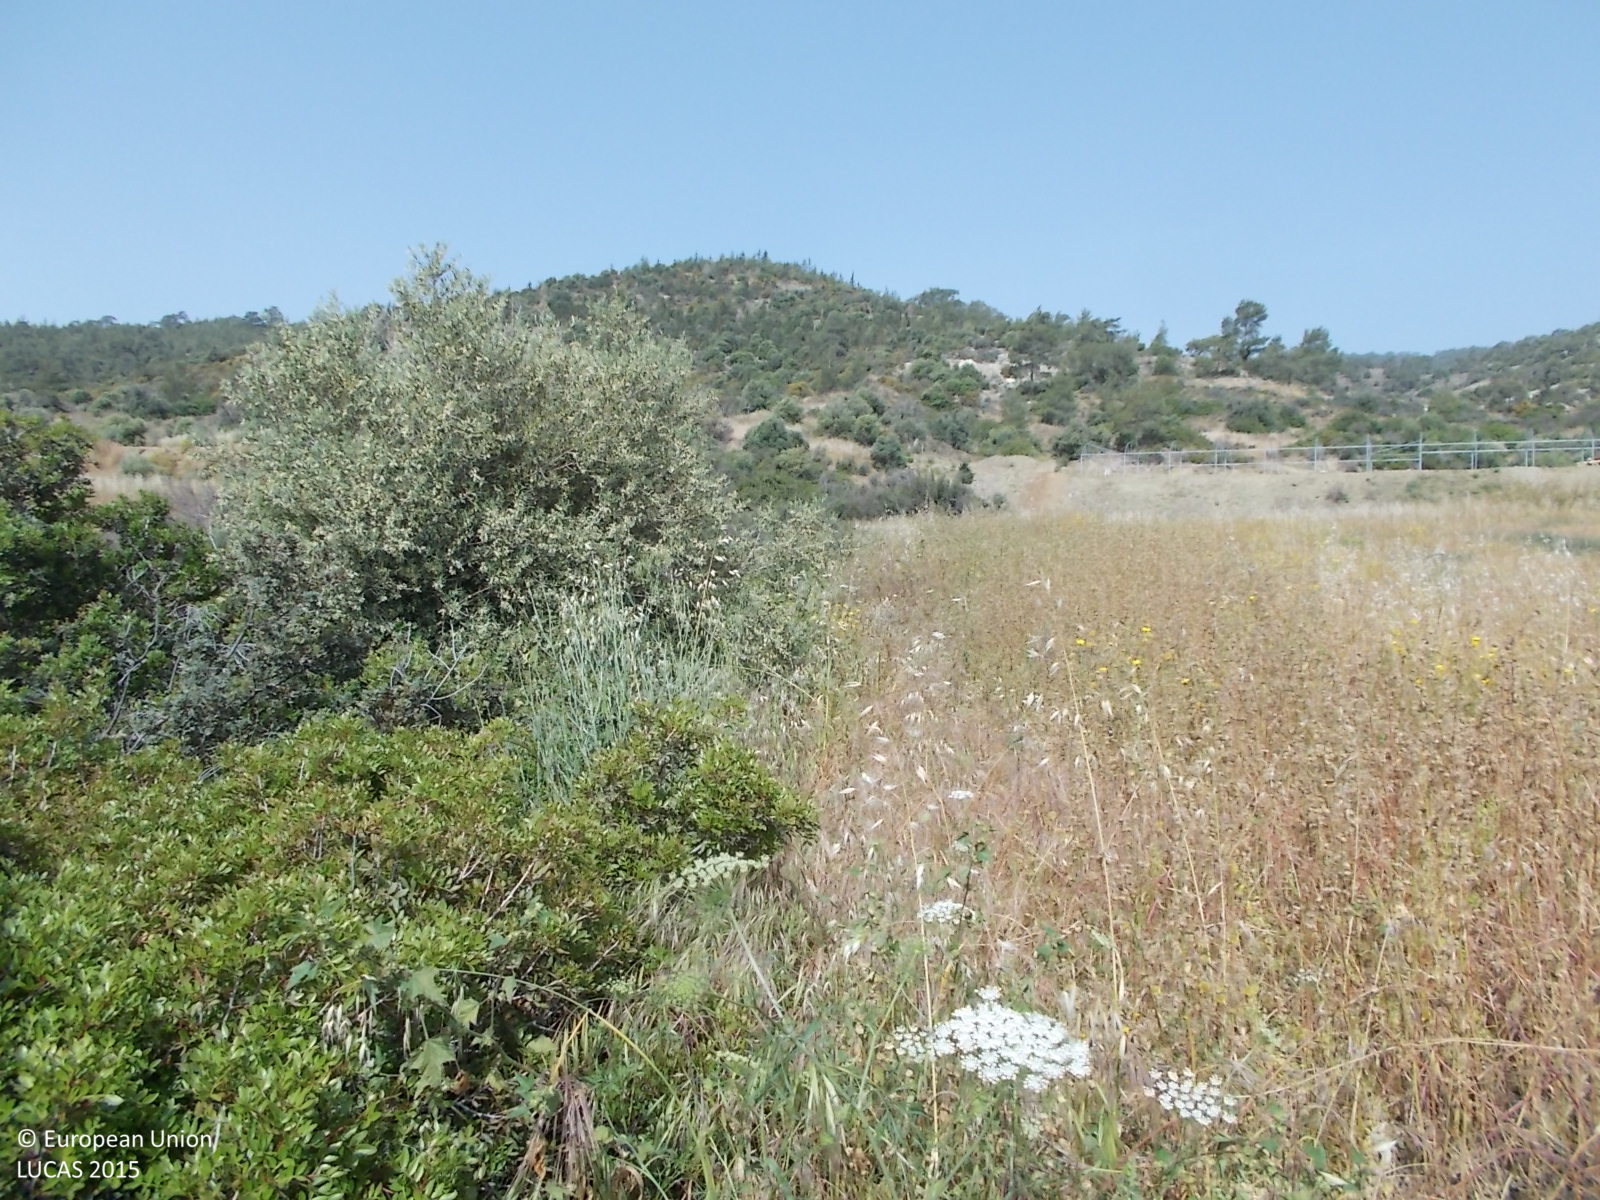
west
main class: Grassland
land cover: Spontaneously vegetated surfaces
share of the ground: > 75 %
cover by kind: herbaceous plants 100 %
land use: Fallow land
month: April
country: CY
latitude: 34.7739
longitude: 33.1512
